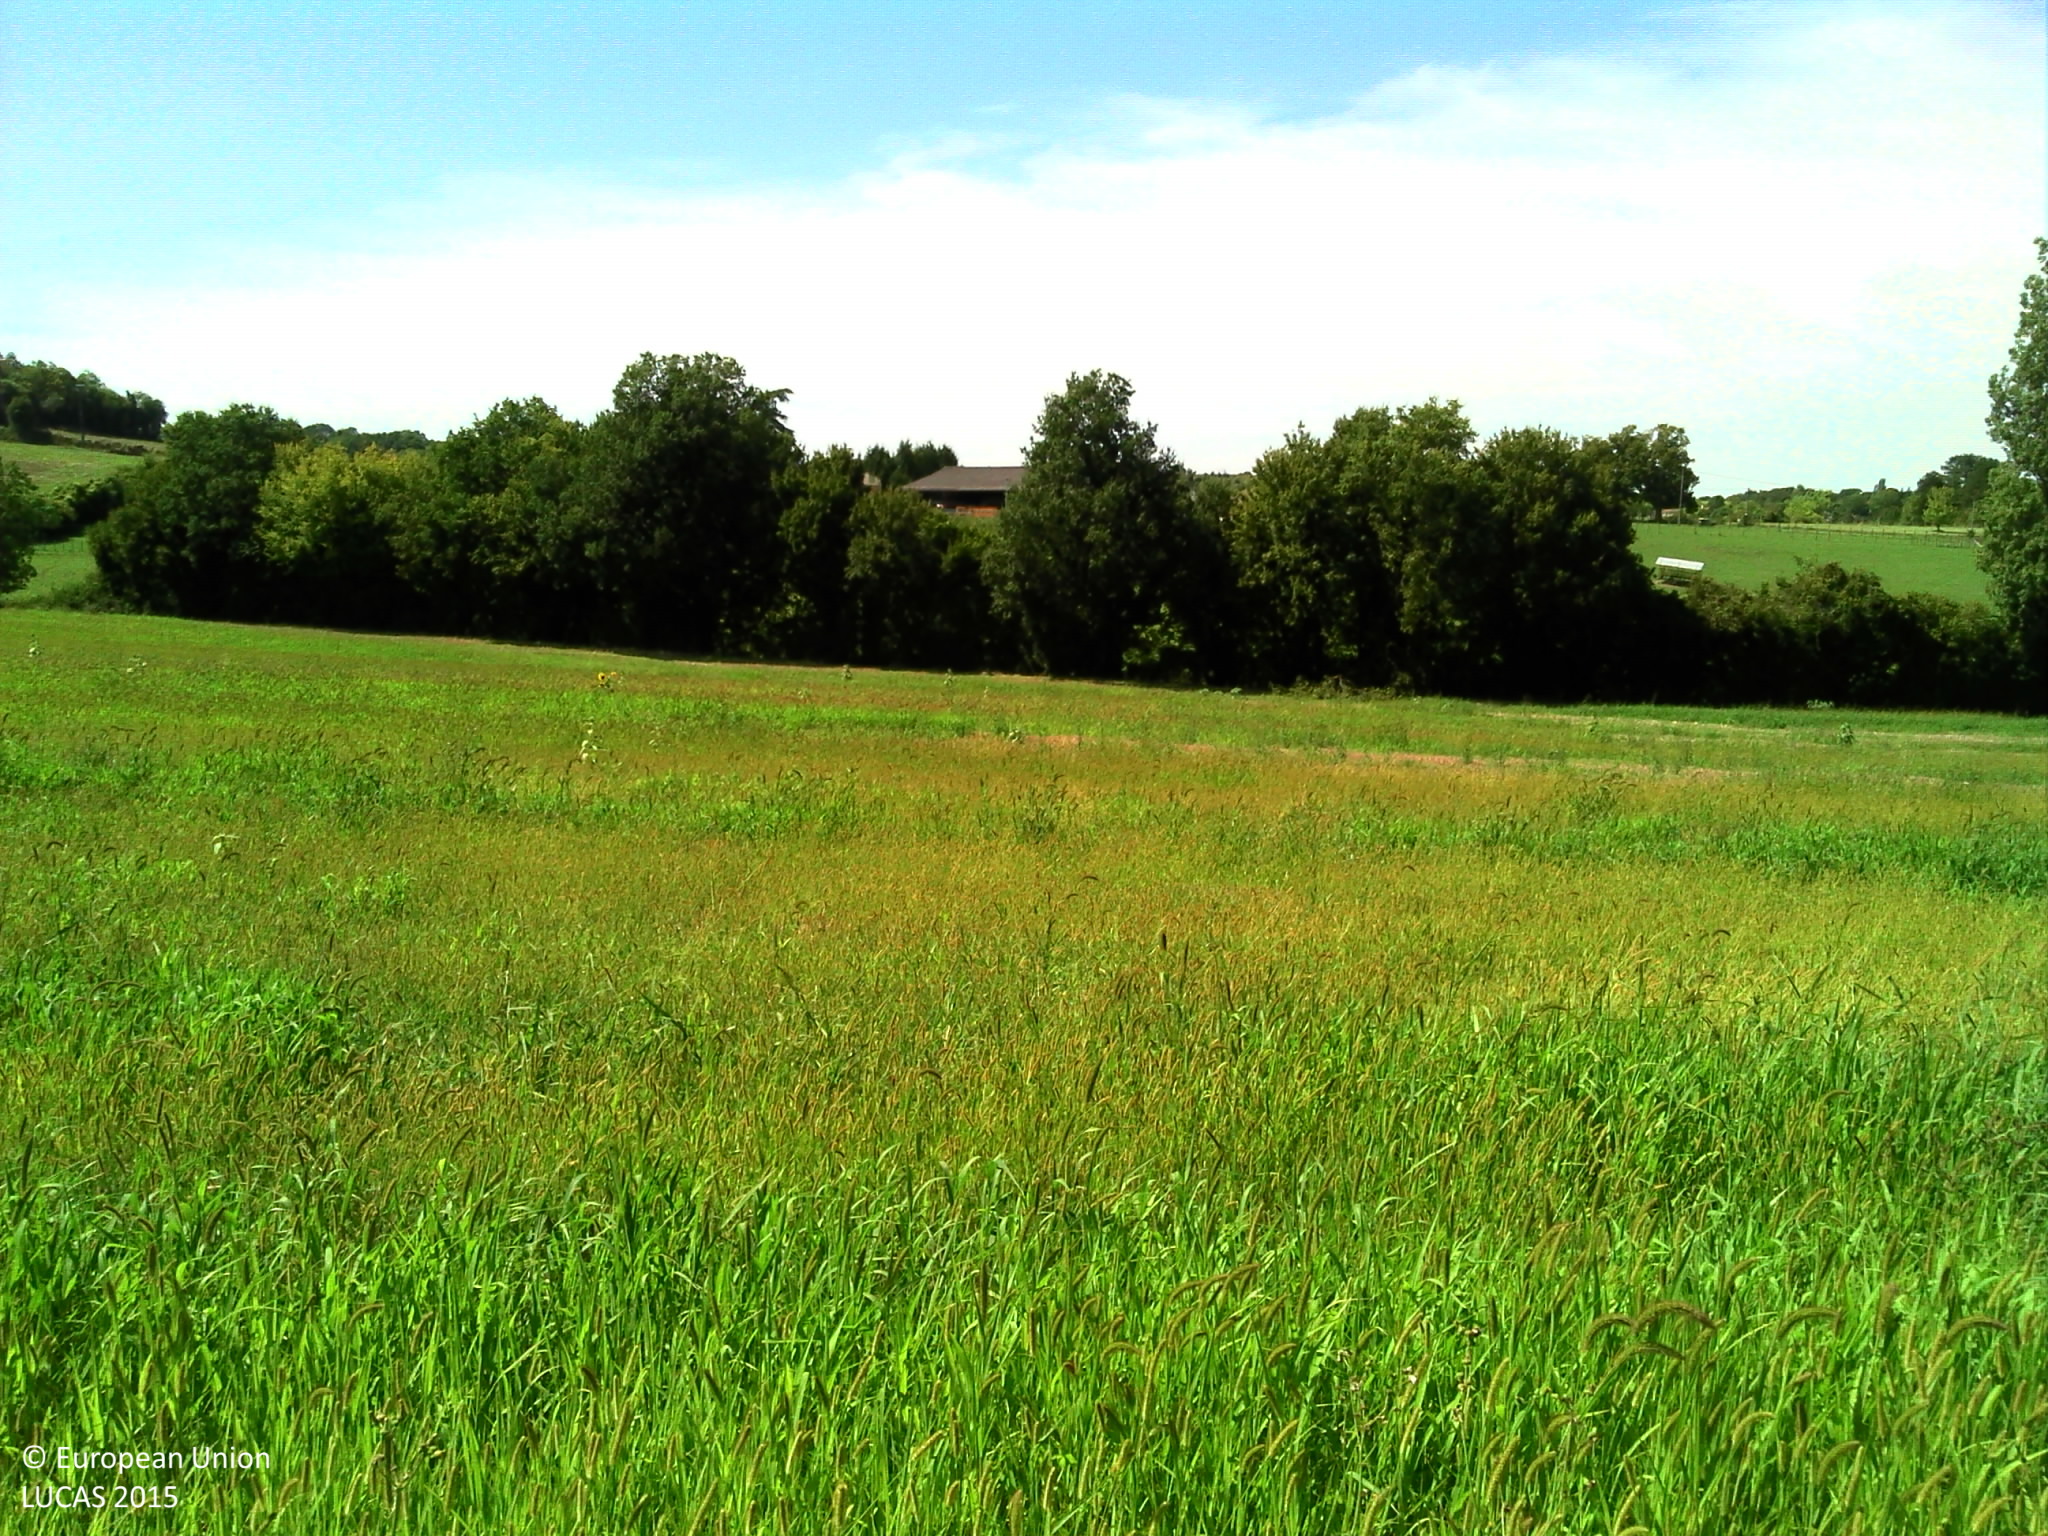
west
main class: Grassland
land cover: Grassland without tree/shrub cover
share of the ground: > 75 %
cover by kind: herbaceous plants 100 %
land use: Agriculture (excluding fallow land and kitchen gardens)
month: August
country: FR
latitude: 45.2382
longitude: 0.4979
